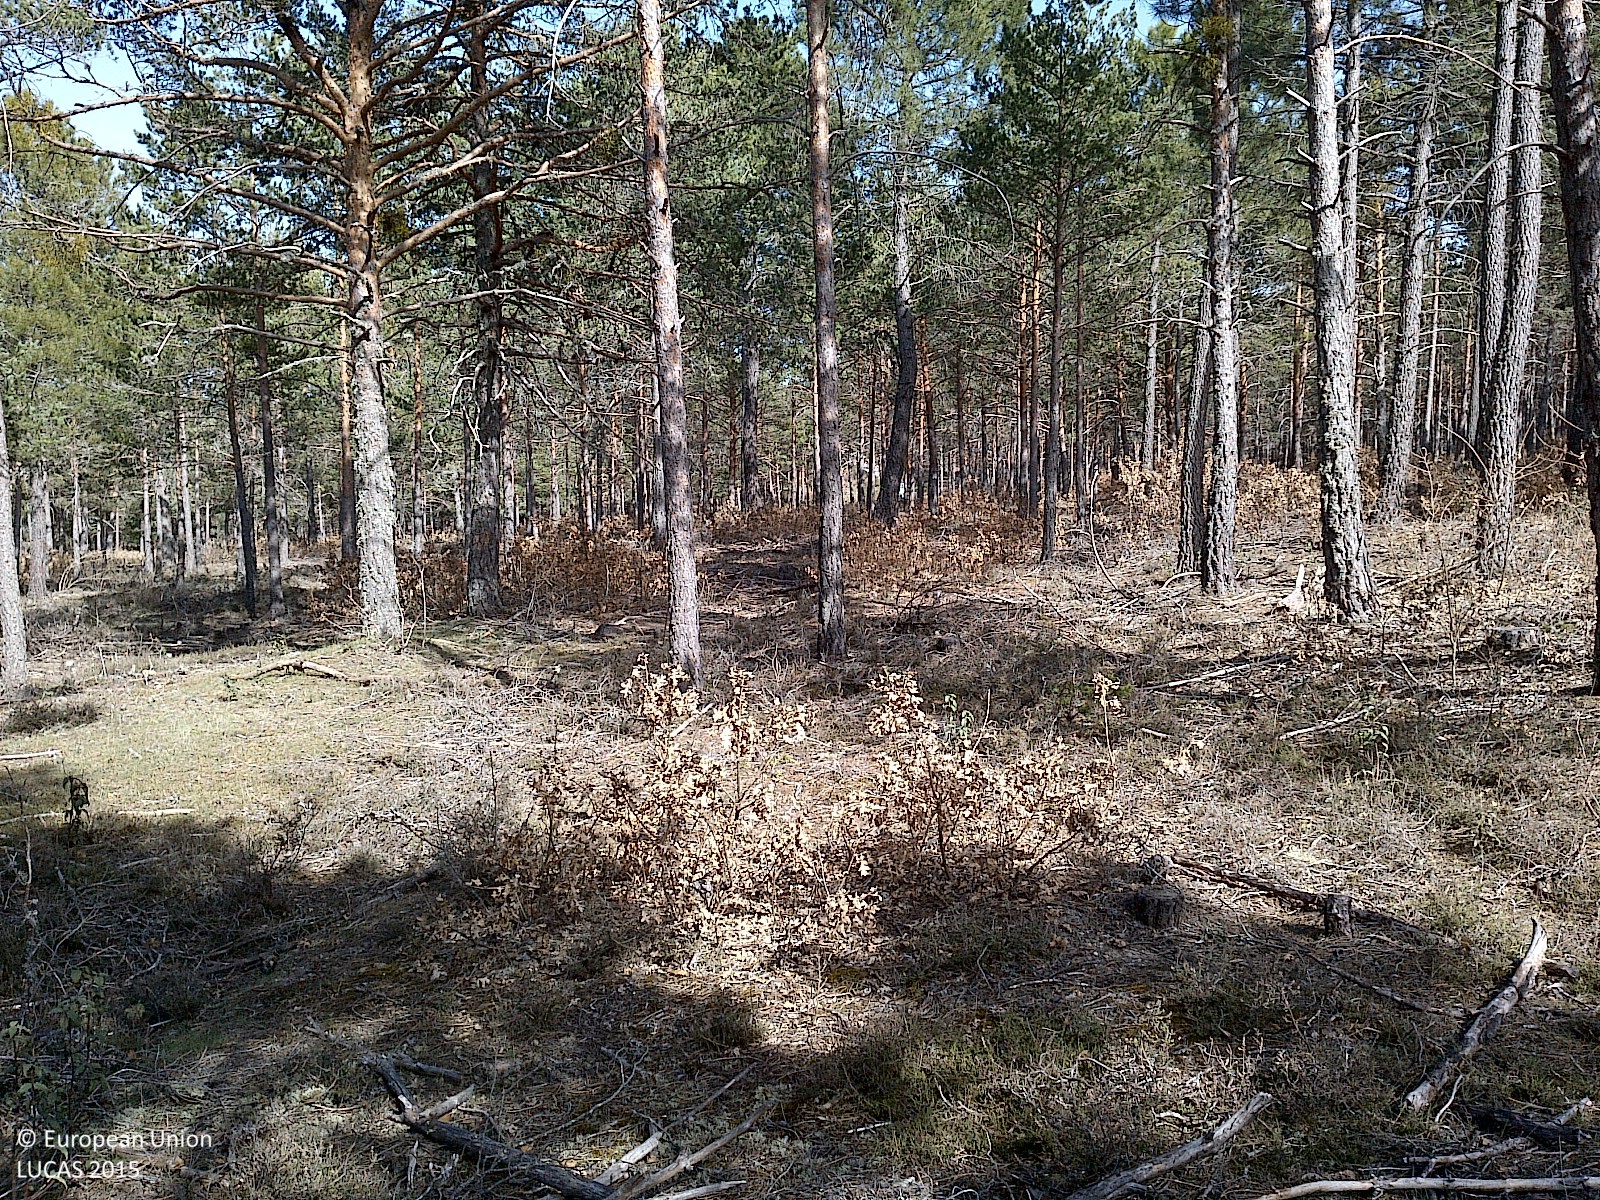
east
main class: Woodland
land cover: Pine dominated coniferous woodland
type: coniferous forest of the mediterranean region
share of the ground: > 75 %
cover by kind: coniferous forest trees 85 %, herbaceous plants 10 %, shrubs 5 %
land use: Forestry
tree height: > 5 m
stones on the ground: < 10 %
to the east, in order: Pine dominated coniferous woodland; Tracks; Pine dominated coniferous woodland
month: April
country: ES
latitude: 41.8535
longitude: -2.8231
